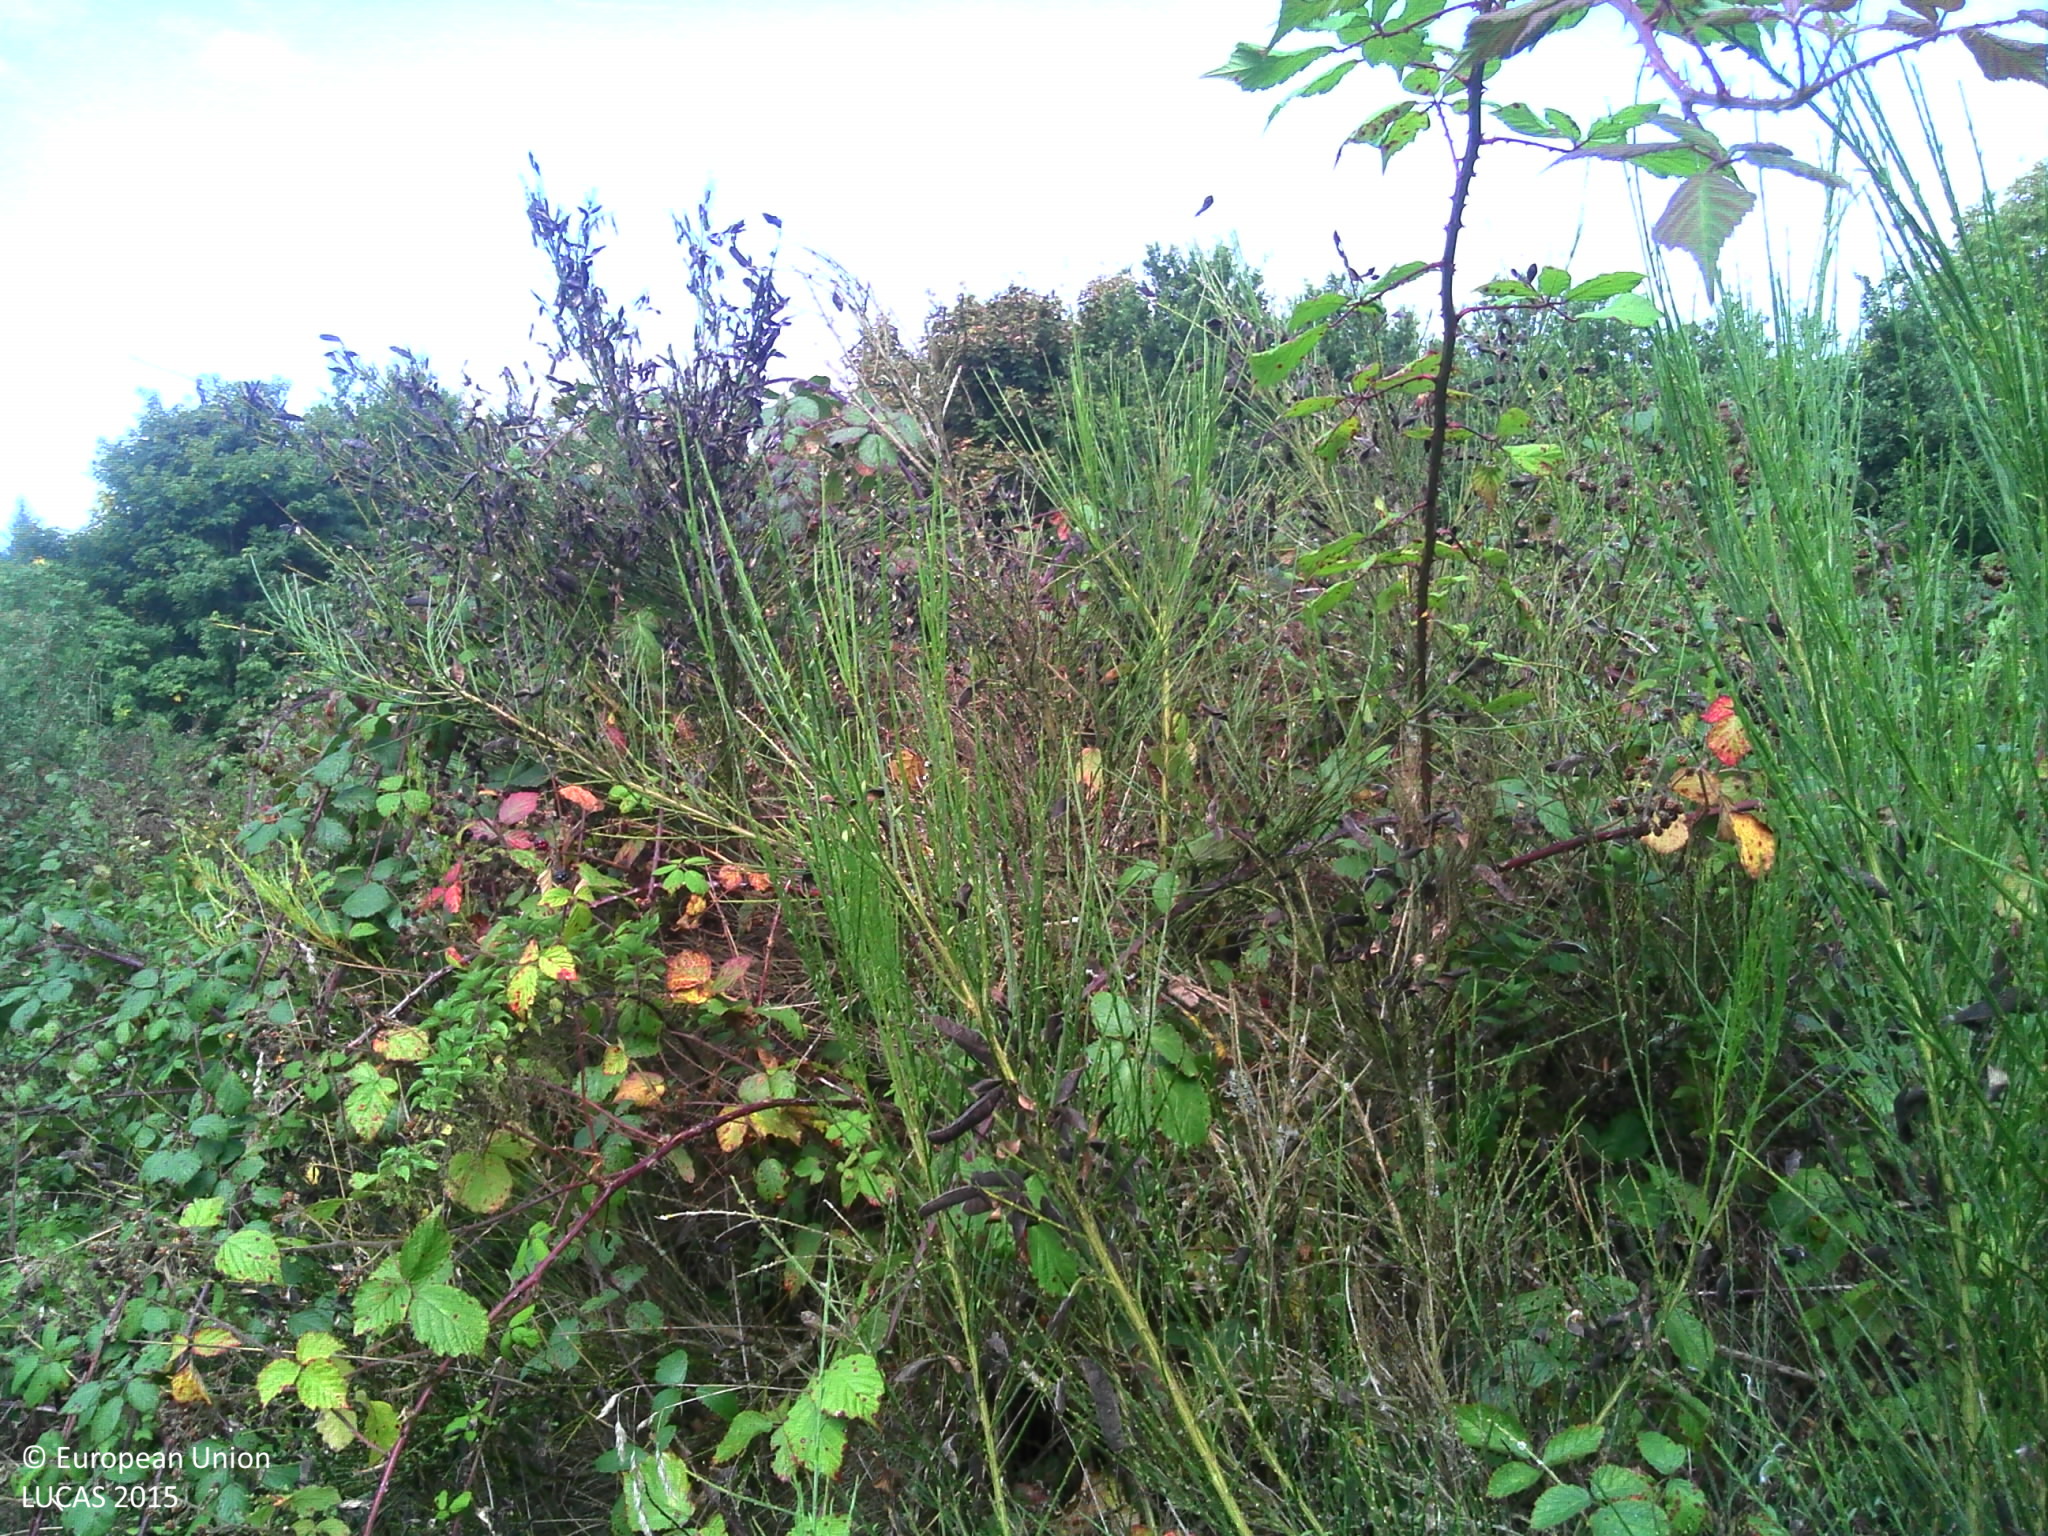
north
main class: Shrubland
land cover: Shrubland without tree cover
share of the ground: > 75 %
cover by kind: shrubs 100 %
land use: Semi-natural and natural areas not in use
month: October
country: FR
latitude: 48.5089
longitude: -3.1347
